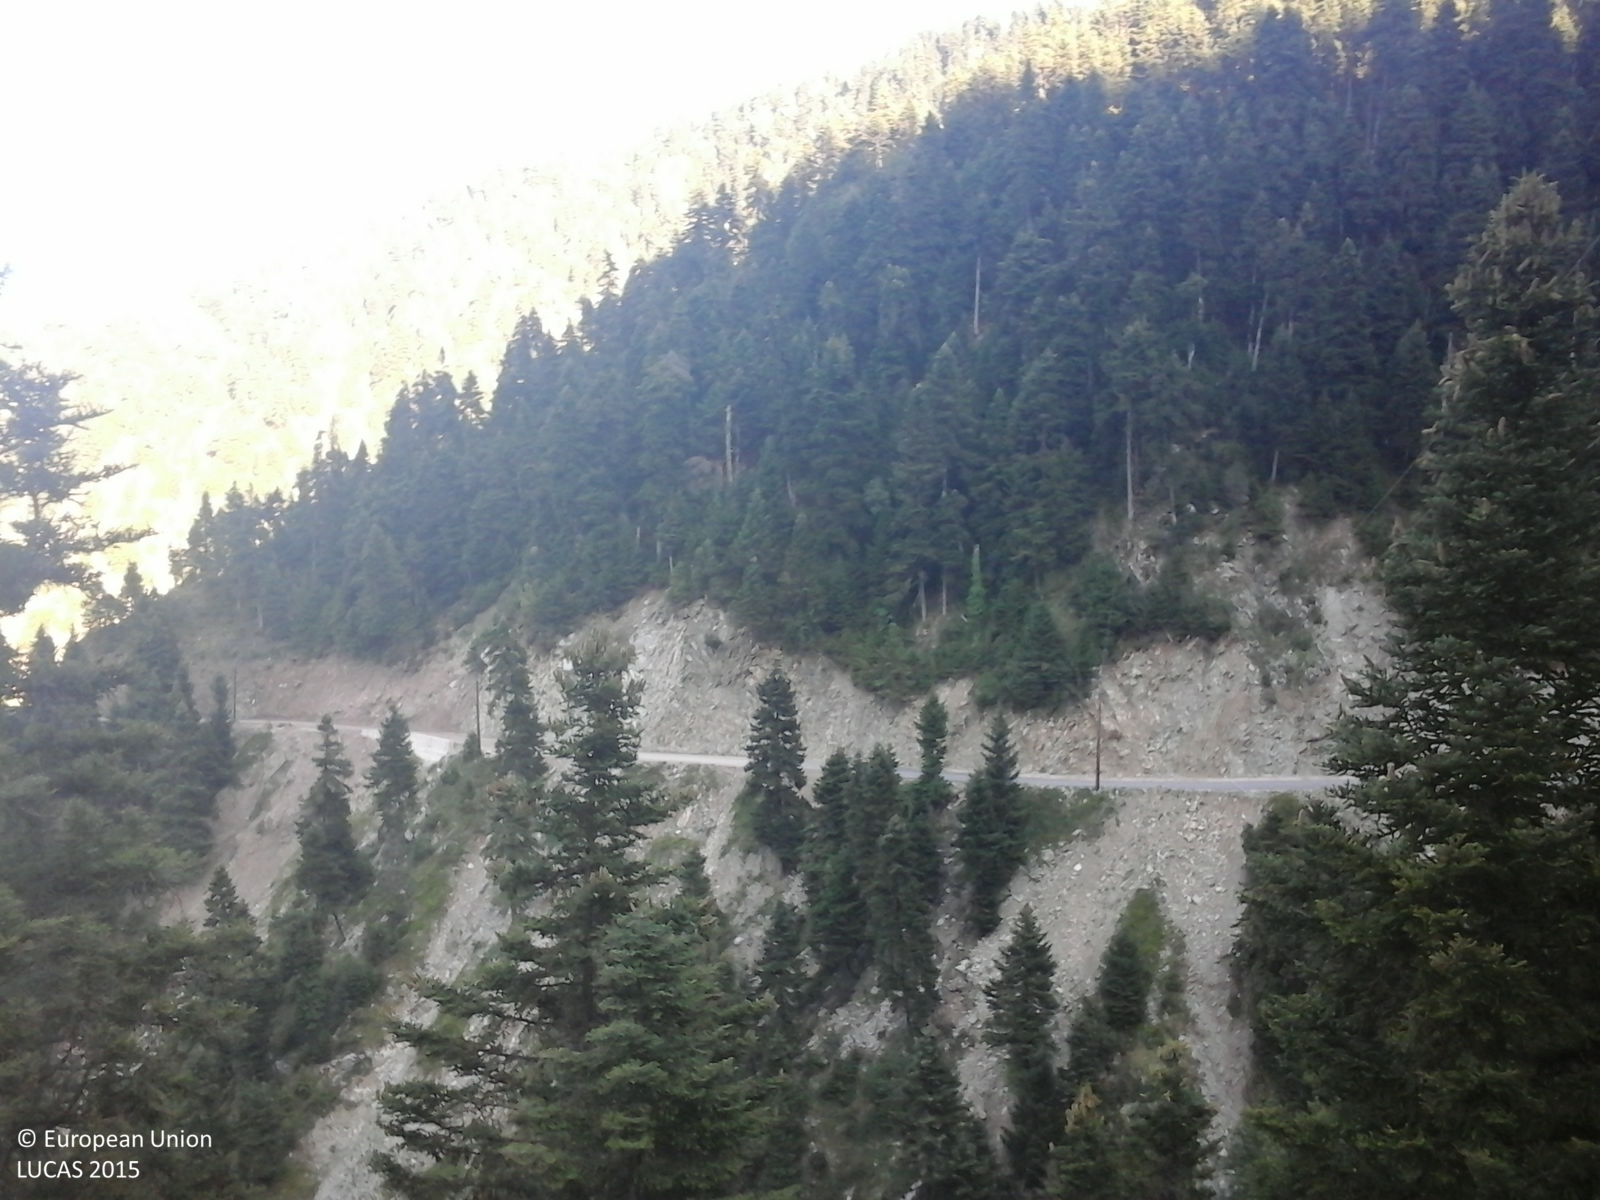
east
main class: Woodland
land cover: Spruce dominated coniferous woodland
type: coniferous forest of the mediterranean region
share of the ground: > 75 %
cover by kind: coniferous forest trees 75 %, unconsolidated bare surface 25 %
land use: Semi-natural and natural areas not in use
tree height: > 5 m
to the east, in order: Spruce dominated coniferous woodland; Rivers and streams; Spruce dominated coniferous woodland; Electric lines; Paved roads, cycling and walking lanes; Spruce dominated coniferous woodland
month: August
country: GR
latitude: 38.7428
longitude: 21.6970
